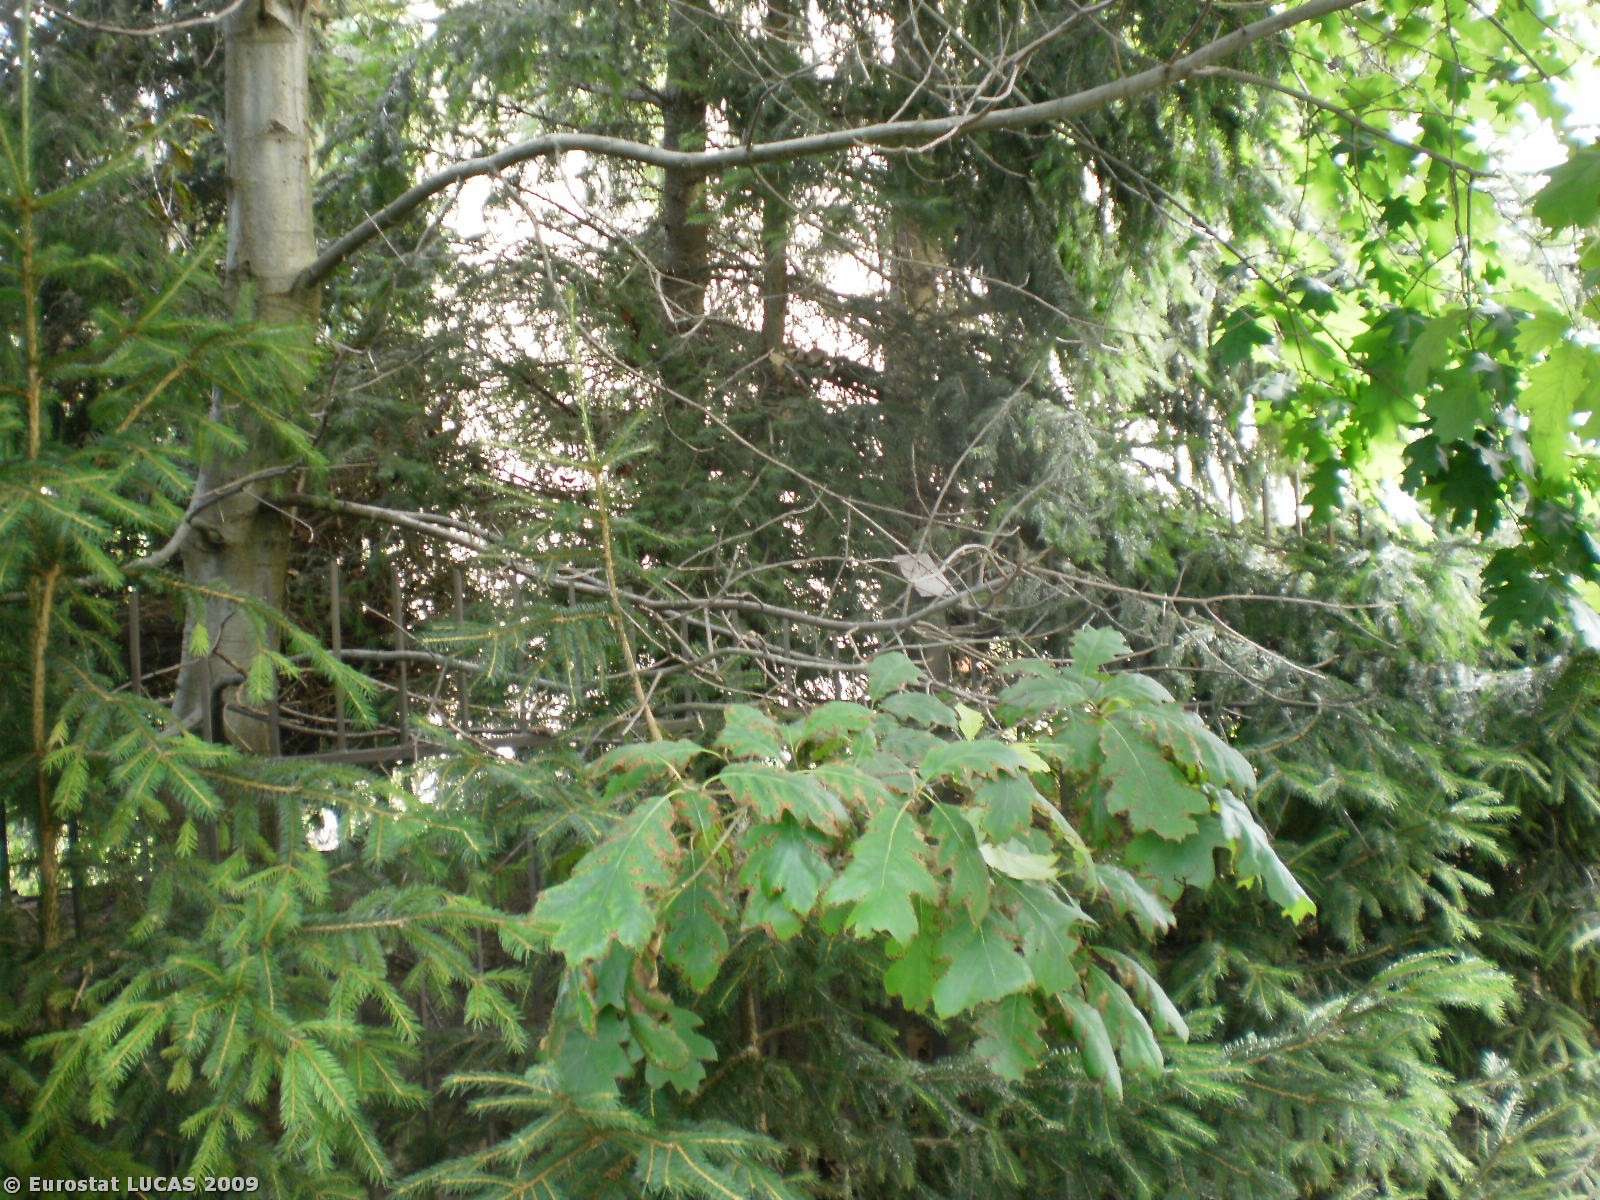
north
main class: Artificial land
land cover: Non built-up linear features
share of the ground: 25 - 50 %
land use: Residential
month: July
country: PL
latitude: 53.7435
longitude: 20.4837
